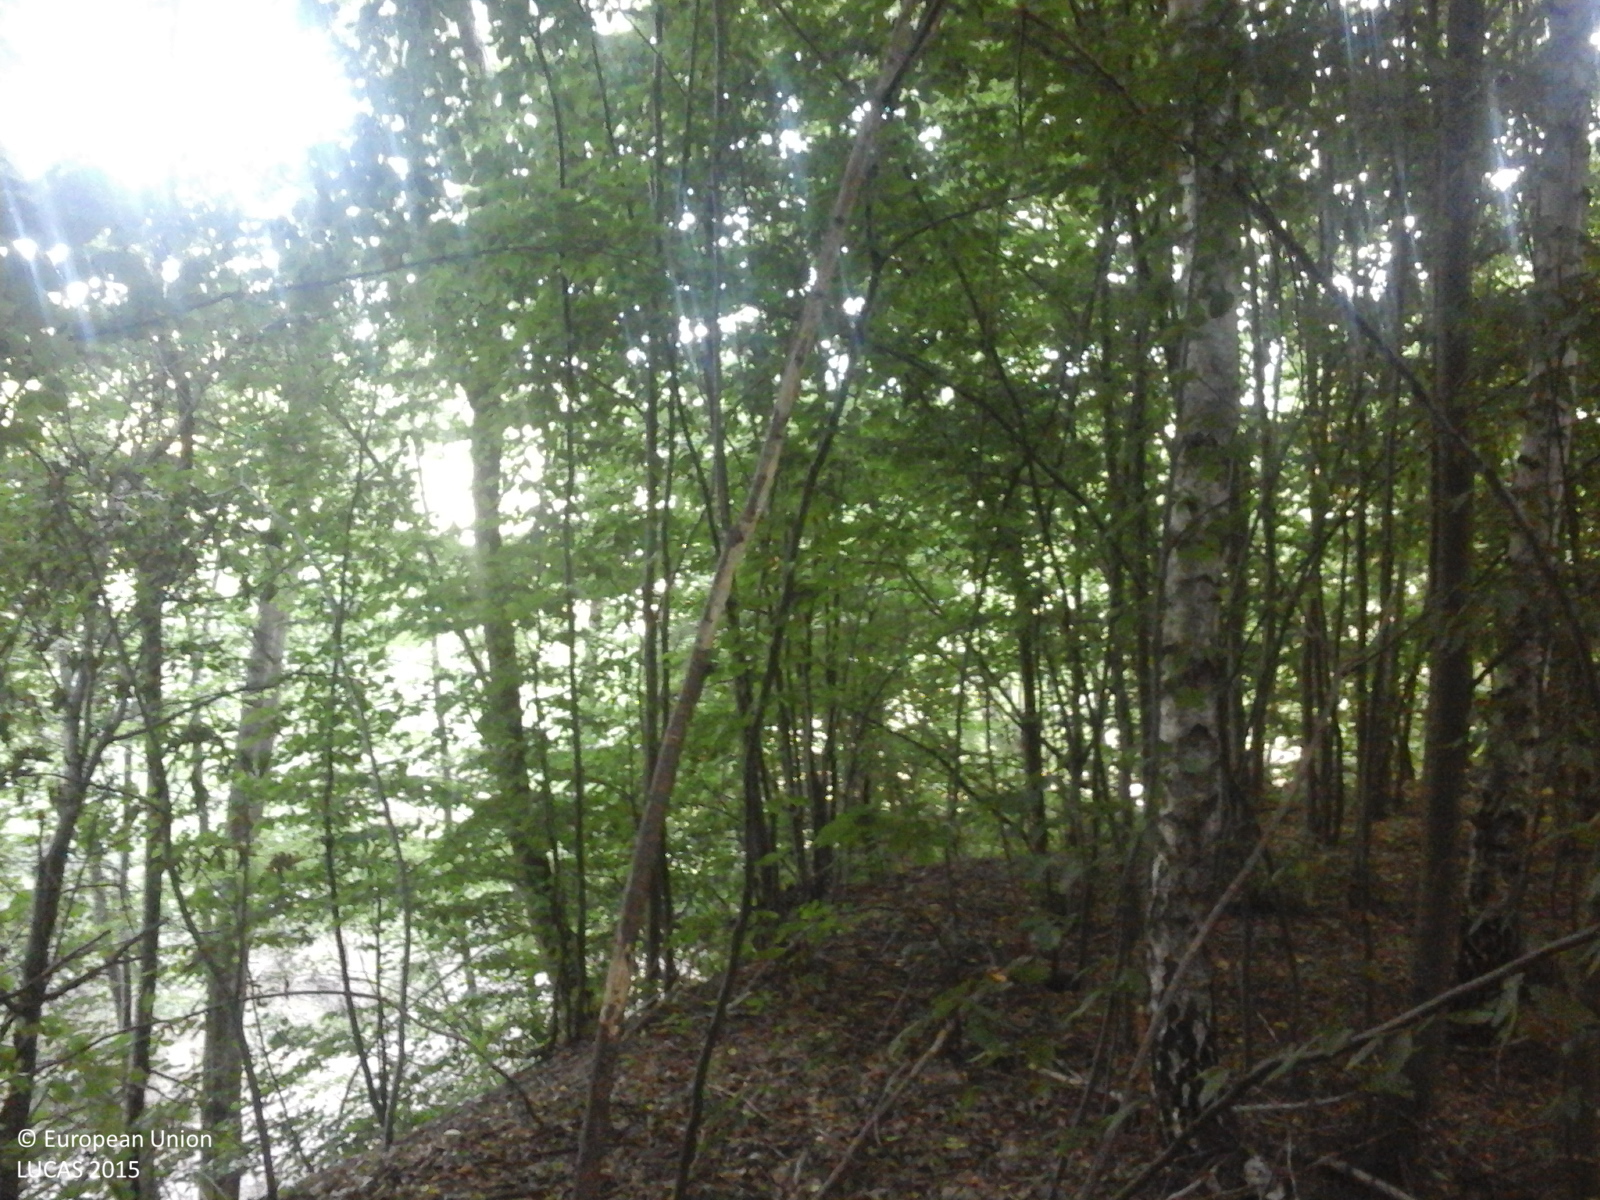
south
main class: Woodland
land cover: Broadleaved woodland
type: beech forest
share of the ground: > 75 %
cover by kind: broadleaved forest trees 100 %
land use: Forestry
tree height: > 5 m
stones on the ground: 10 - 25 %
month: July
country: RO
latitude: 45.0584
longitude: 24.5406
